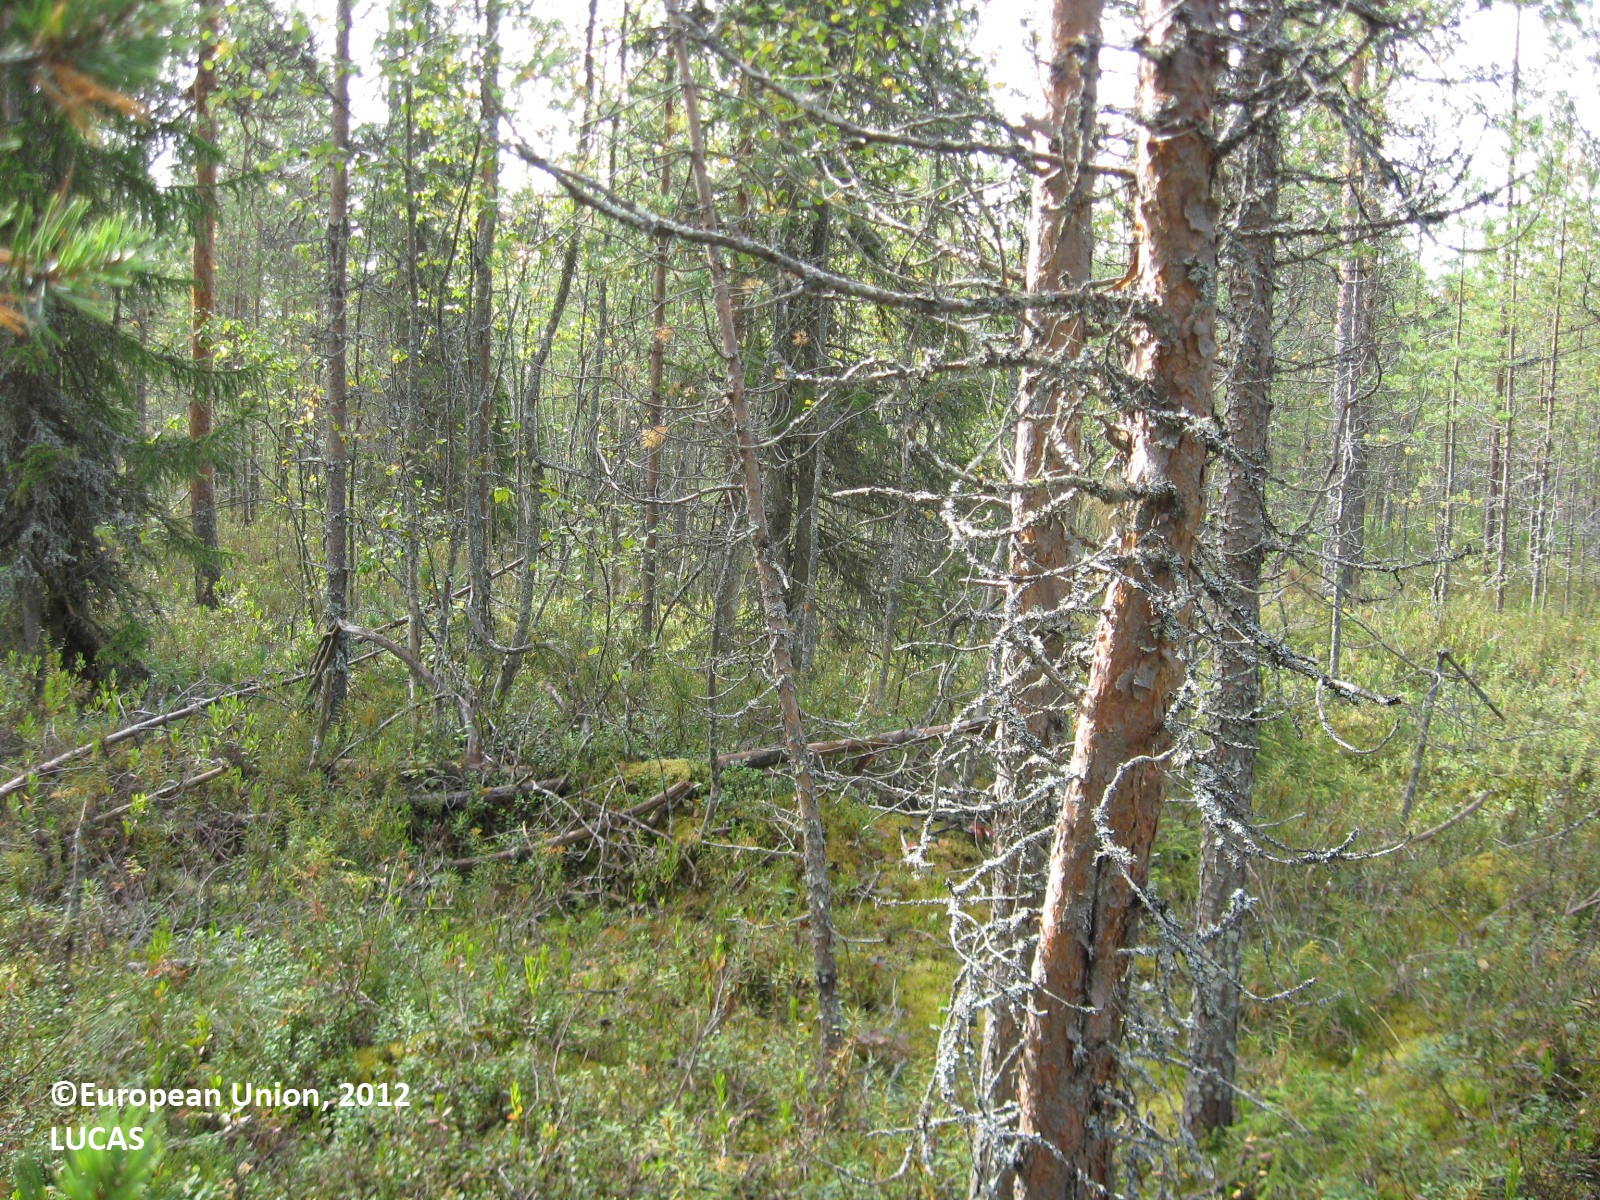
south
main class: Woodland
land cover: Pine dominated coniferous woodland
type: boreal forest
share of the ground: 50 - 75 %
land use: Forestry
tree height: > 5 m
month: August
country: FI
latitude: 63.6654
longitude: 29.5634
